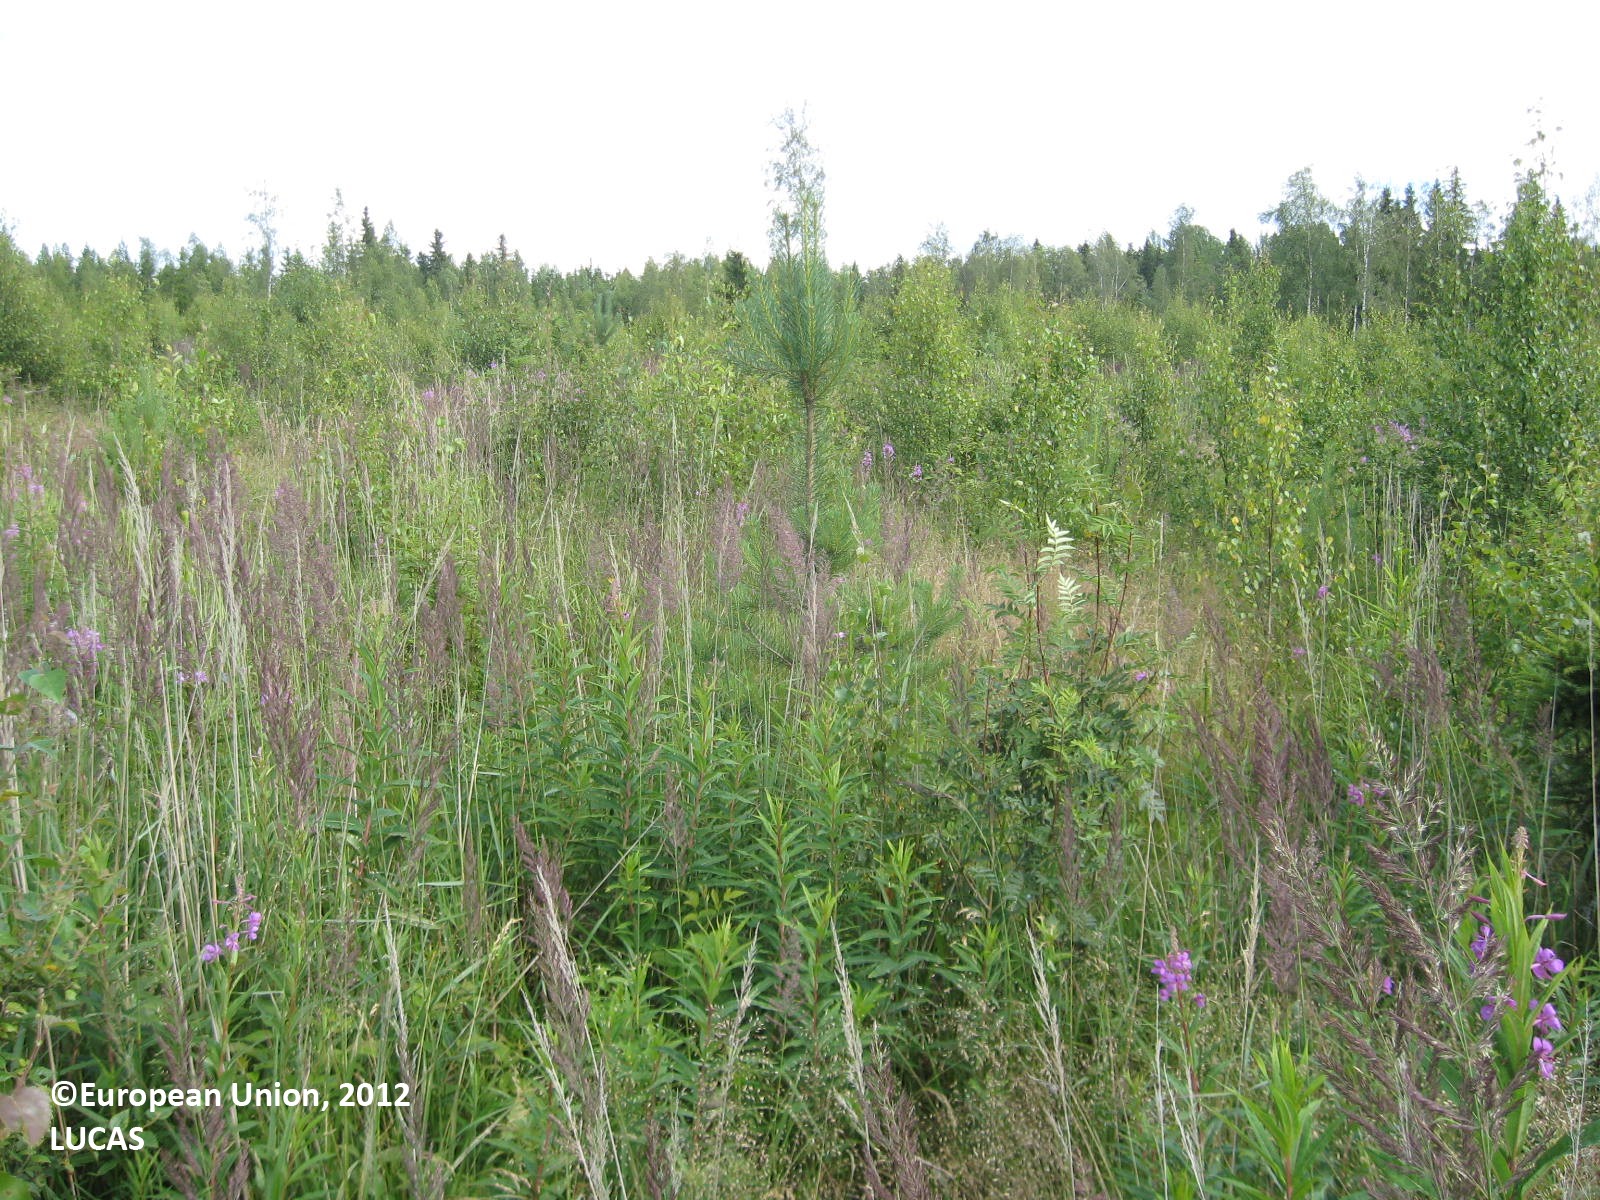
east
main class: Woodland
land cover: Other mixed woodland
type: boreal forest
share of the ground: 50 - 75 %
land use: Forestry
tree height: < 5 m
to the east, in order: Other mixed woodland; Tracks; Other mixed woodland; Ditches and canals; Other mixed woodland
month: July
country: FI
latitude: 62.0100
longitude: 21.4491
